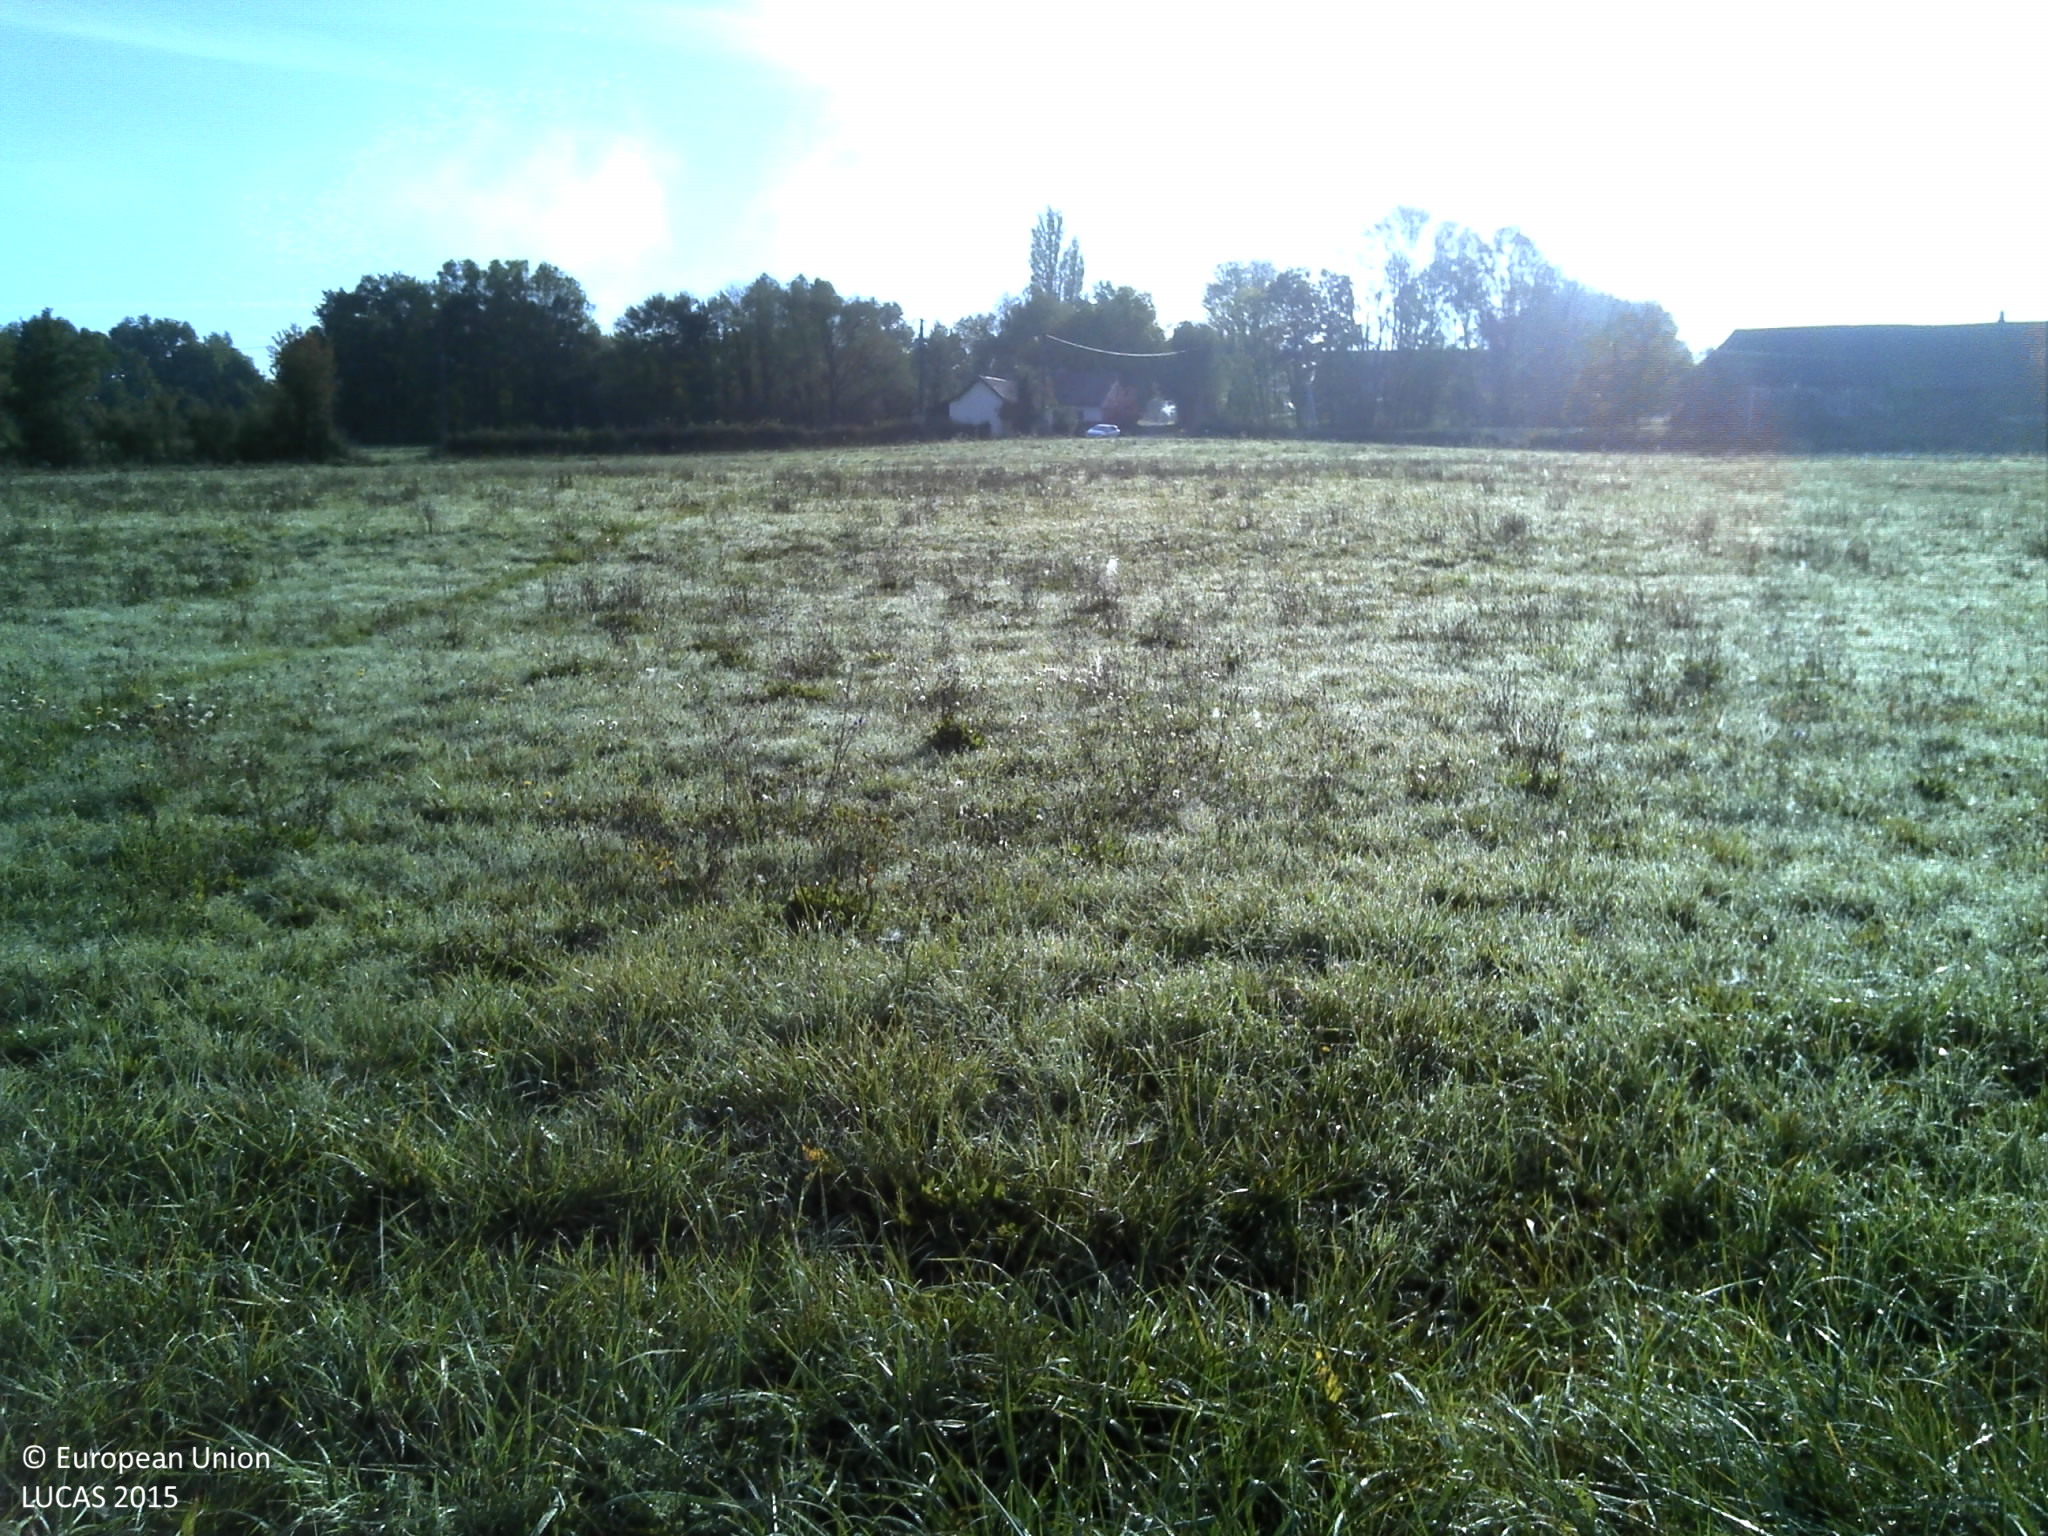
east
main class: Grassland
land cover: Grassland without tree/shrub cover
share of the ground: > 75 %
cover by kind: herbaceous plants 100 %
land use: Agriculture (excluding fallow land and kitchen gardens)
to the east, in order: Grassland without tree/shrub cover; Fences; Rivers and streams; Fences; Grassland without tree/shrub cover; Electric lines; Ditches and canals; Paved roads, cycling and walking lanes; Ditches and canals; Managed hedges; Grassland without tree/shrub cover; Electric lines; Grassland without tree/shrub cover; Ditches and canals; Fences; Lines of trees; Grassland with sparse tree/shrub cover
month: October
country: FR
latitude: 46.5926
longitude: 5.3426
